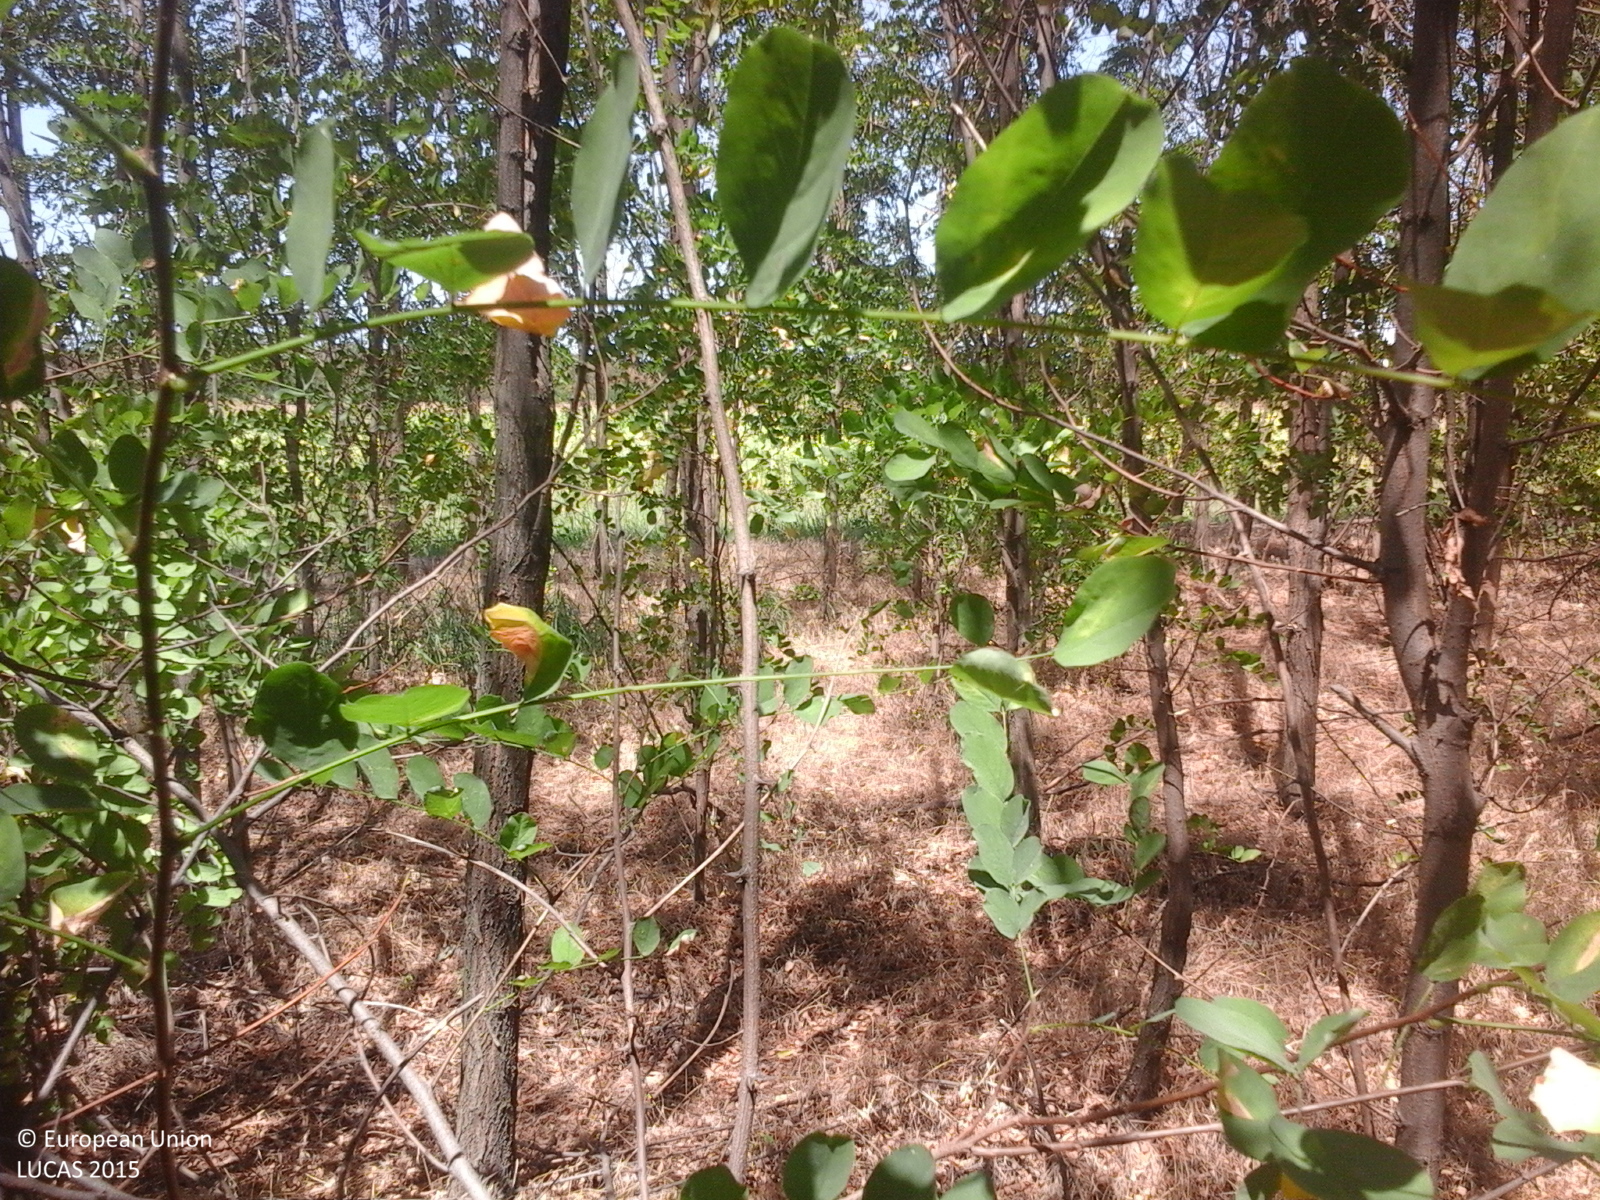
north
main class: Woodland
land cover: Broadleaved woodland
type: exotic forest
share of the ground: > 75 %
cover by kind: broadleaved forest trees 100 %
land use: Forestry
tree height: > 5 m
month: August
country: RO
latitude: 45.8160
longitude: 27.4920
